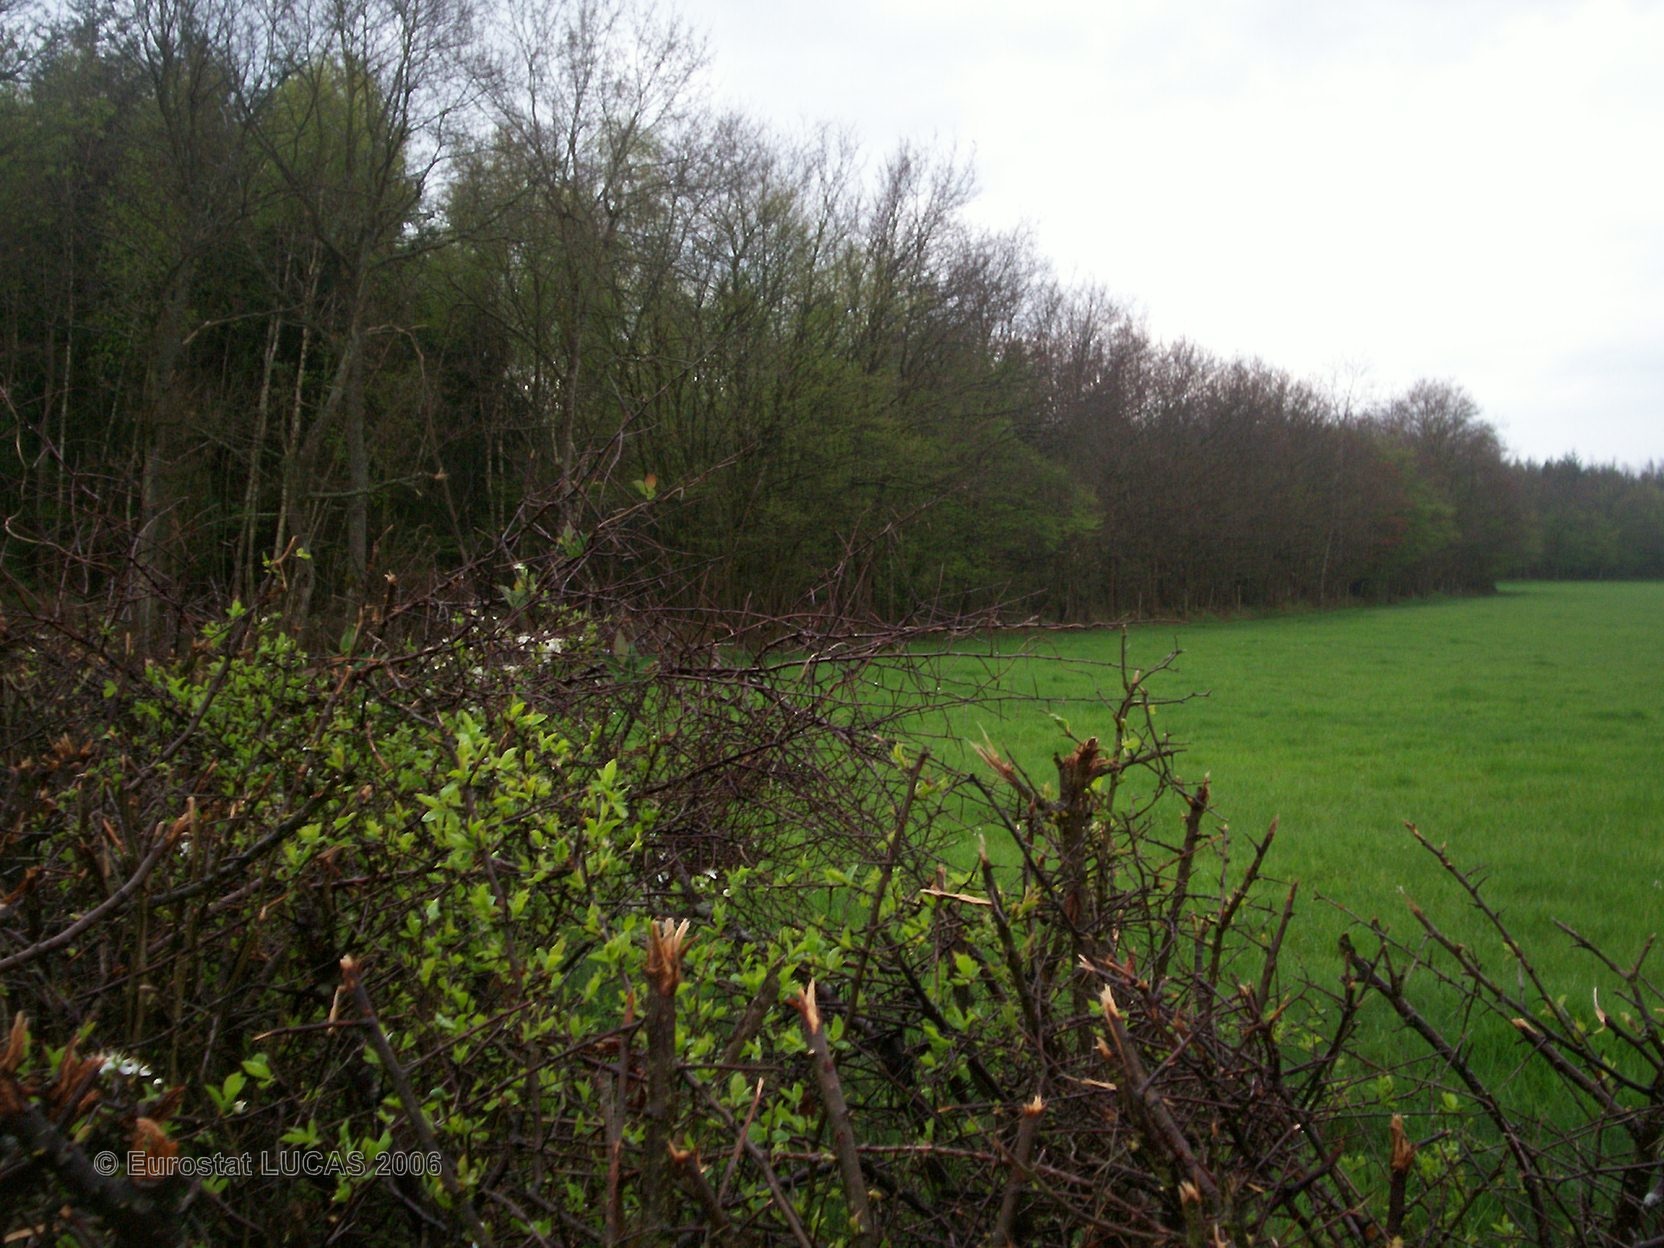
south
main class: Grassland
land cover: Grassland without tree/shrub cover
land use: Agriculture (excluding fallow land and kitchen gardens)
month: April
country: FR
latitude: 46.8291
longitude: 4.6128
